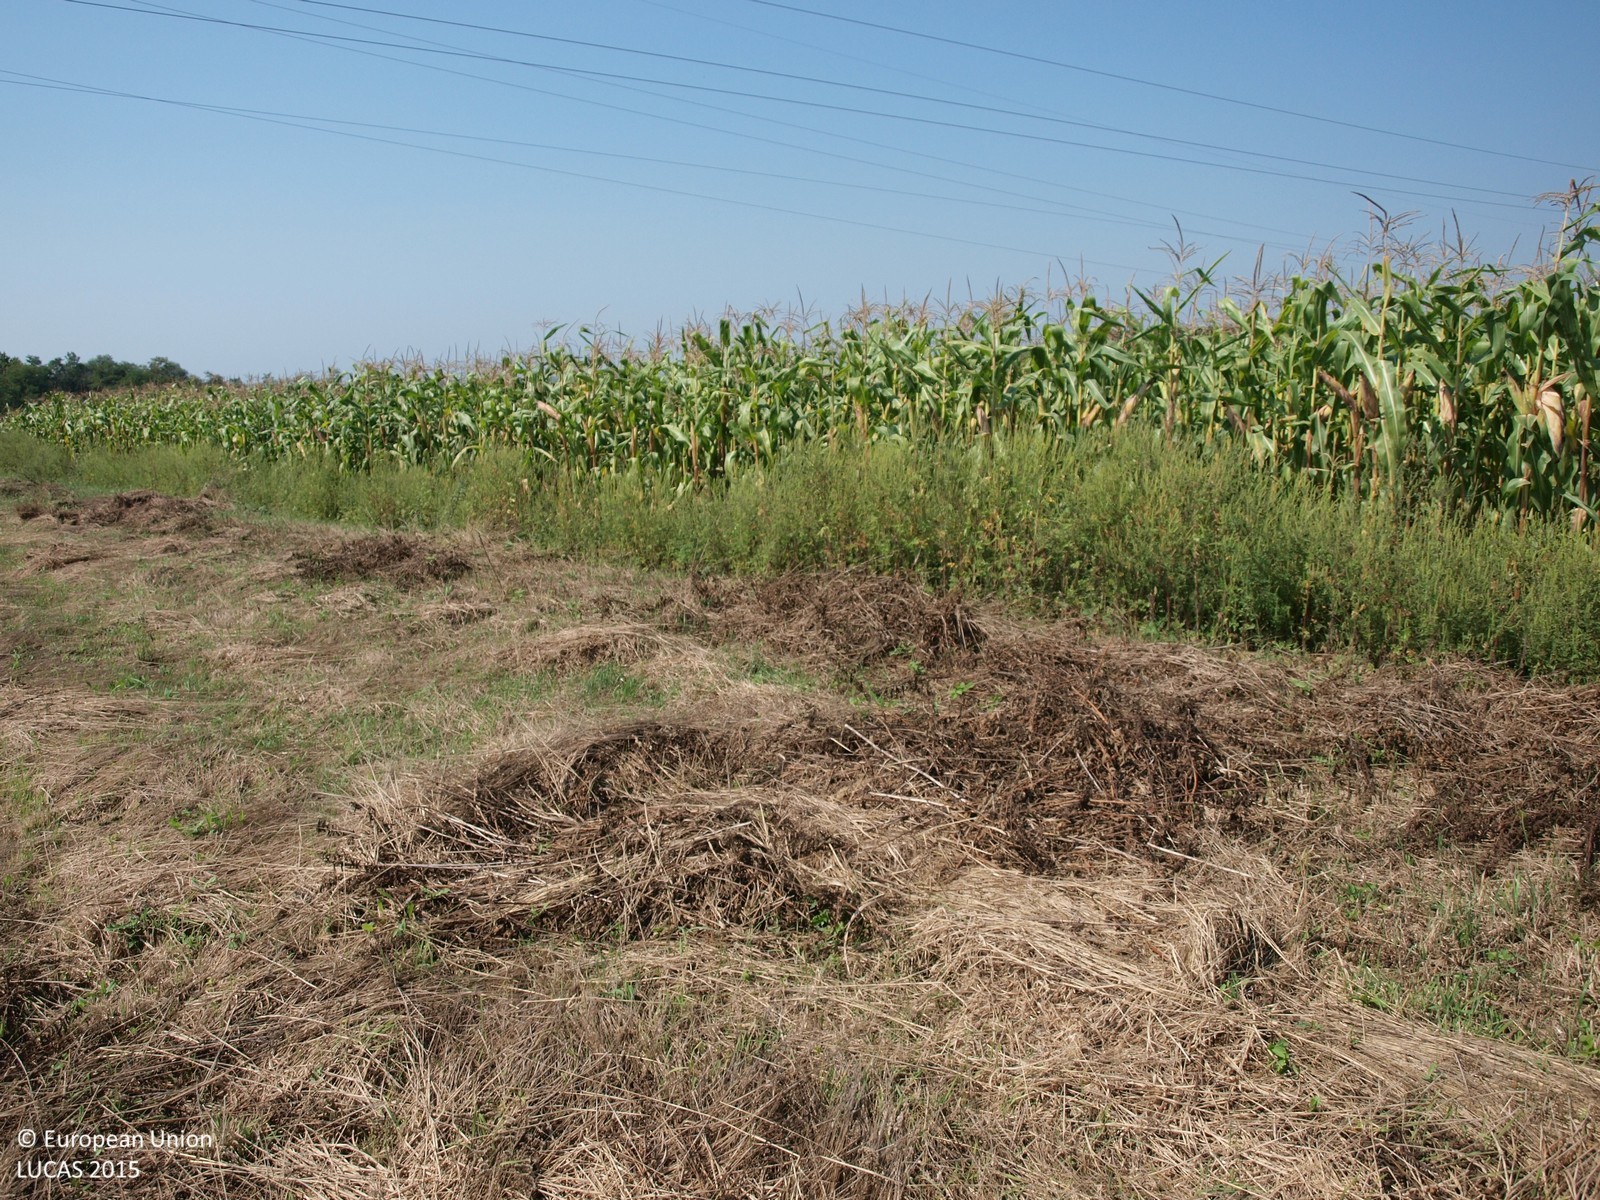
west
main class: Grassland
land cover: Grassland without tree/shrub cover
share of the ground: > 75 %
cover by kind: herbaceous plants 100 %
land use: Agriculture (excluding fallow land and kitchen gardens)
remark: Harvested field
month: August
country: HR
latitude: 45.6831
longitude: 16.5083
